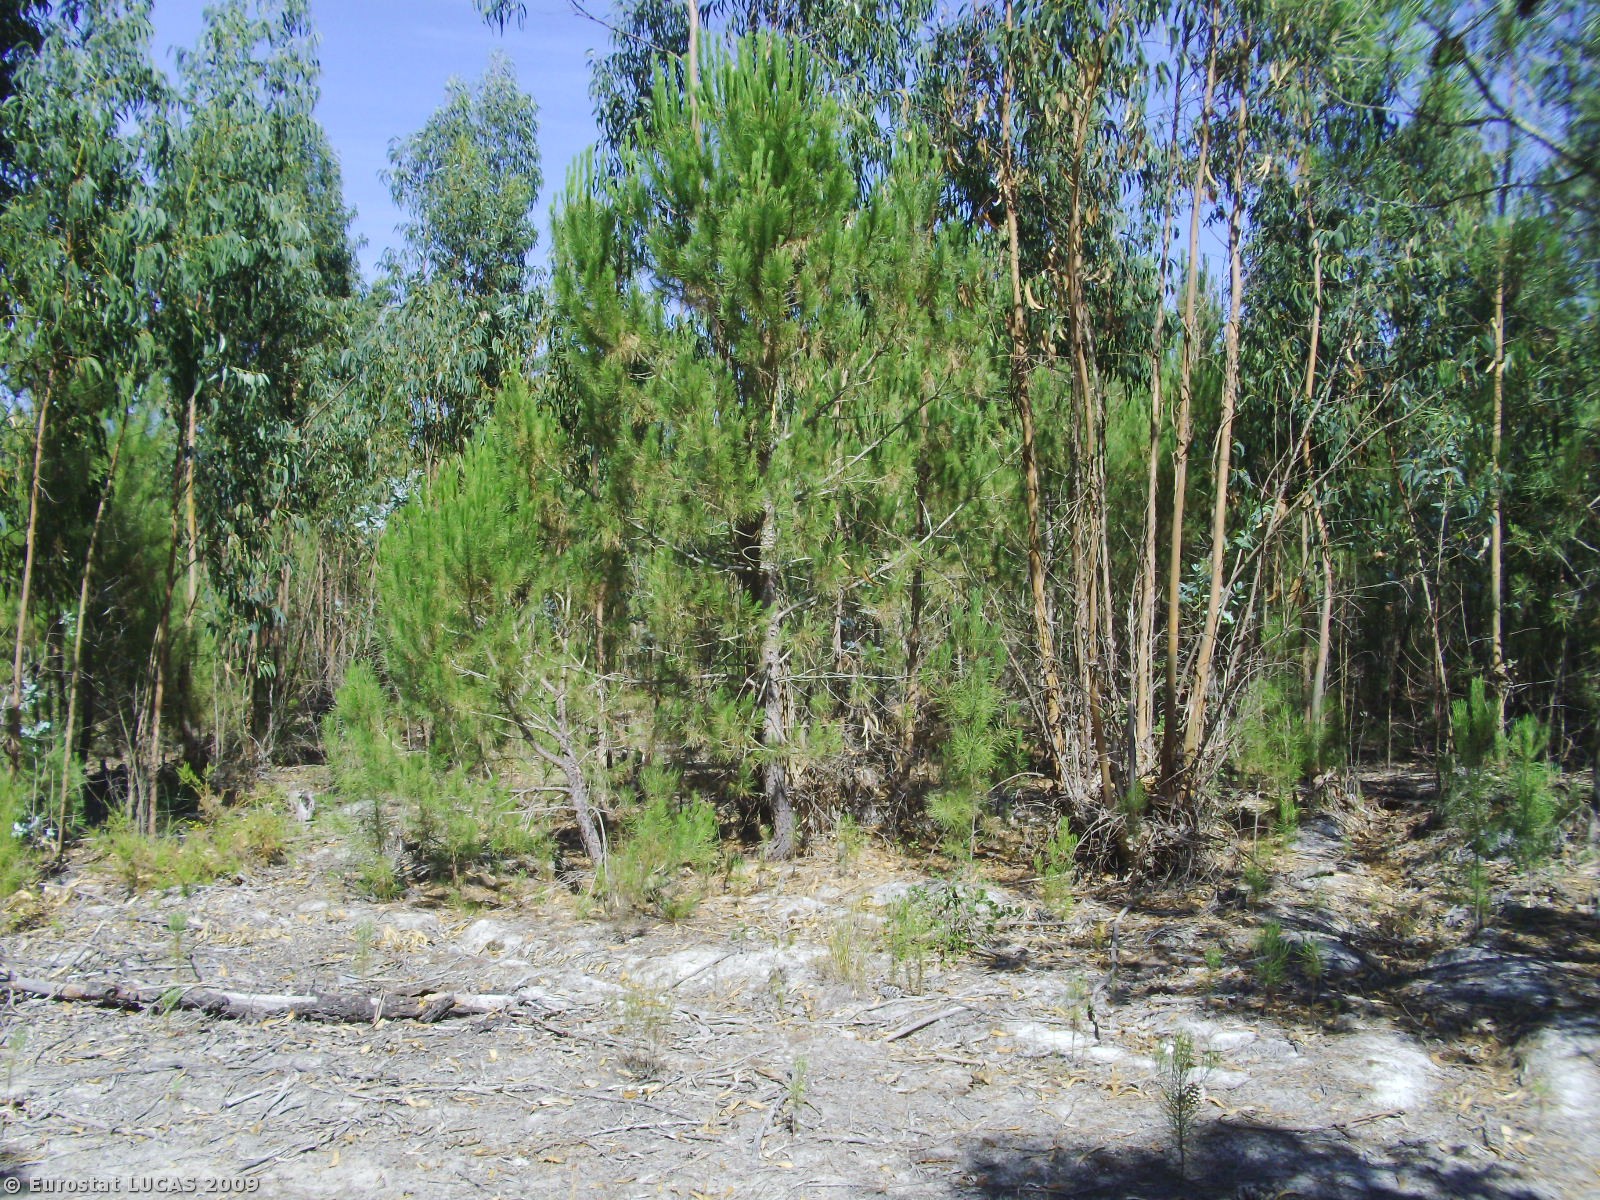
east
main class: Woodland
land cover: Mixed woodland
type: coniferous forest of the mediterranean region
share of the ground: 50 - 75 %
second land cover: Bare land
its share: 25 - 50 %
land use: Forestry
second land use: Fallow land
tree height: > 5 m
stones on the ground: < 10 %
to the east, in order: Mixed woodland; Bare land; Mixed woodland; Tracks; Mixed woodland; Tracks; Mixed woodland; Tracks; Mixed woodland
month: August
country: PT
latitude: 38.7271
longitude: -8.7090
